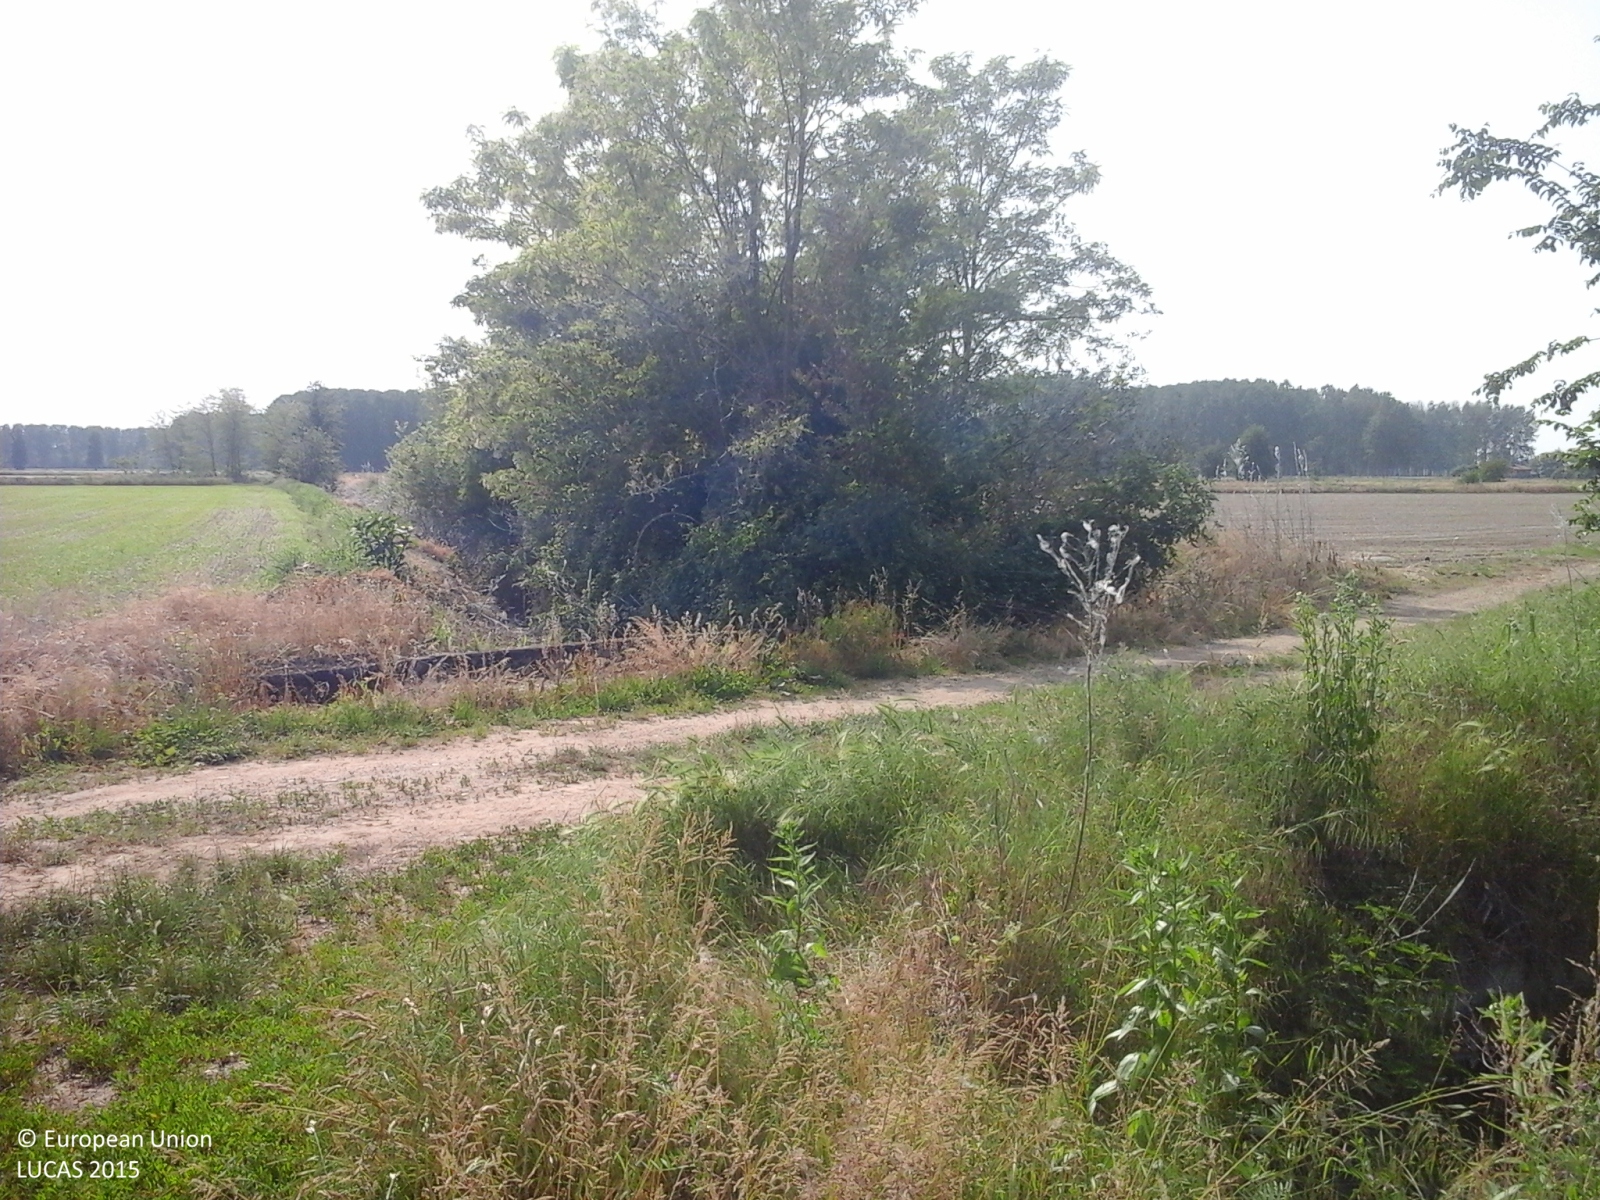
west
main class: Cropland
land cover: Rice
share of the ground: > 75 %
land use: Agriculture (excluding fallow land and kitchen gardens)
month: May
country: IT
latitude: 45.3029
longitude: 9.1725
